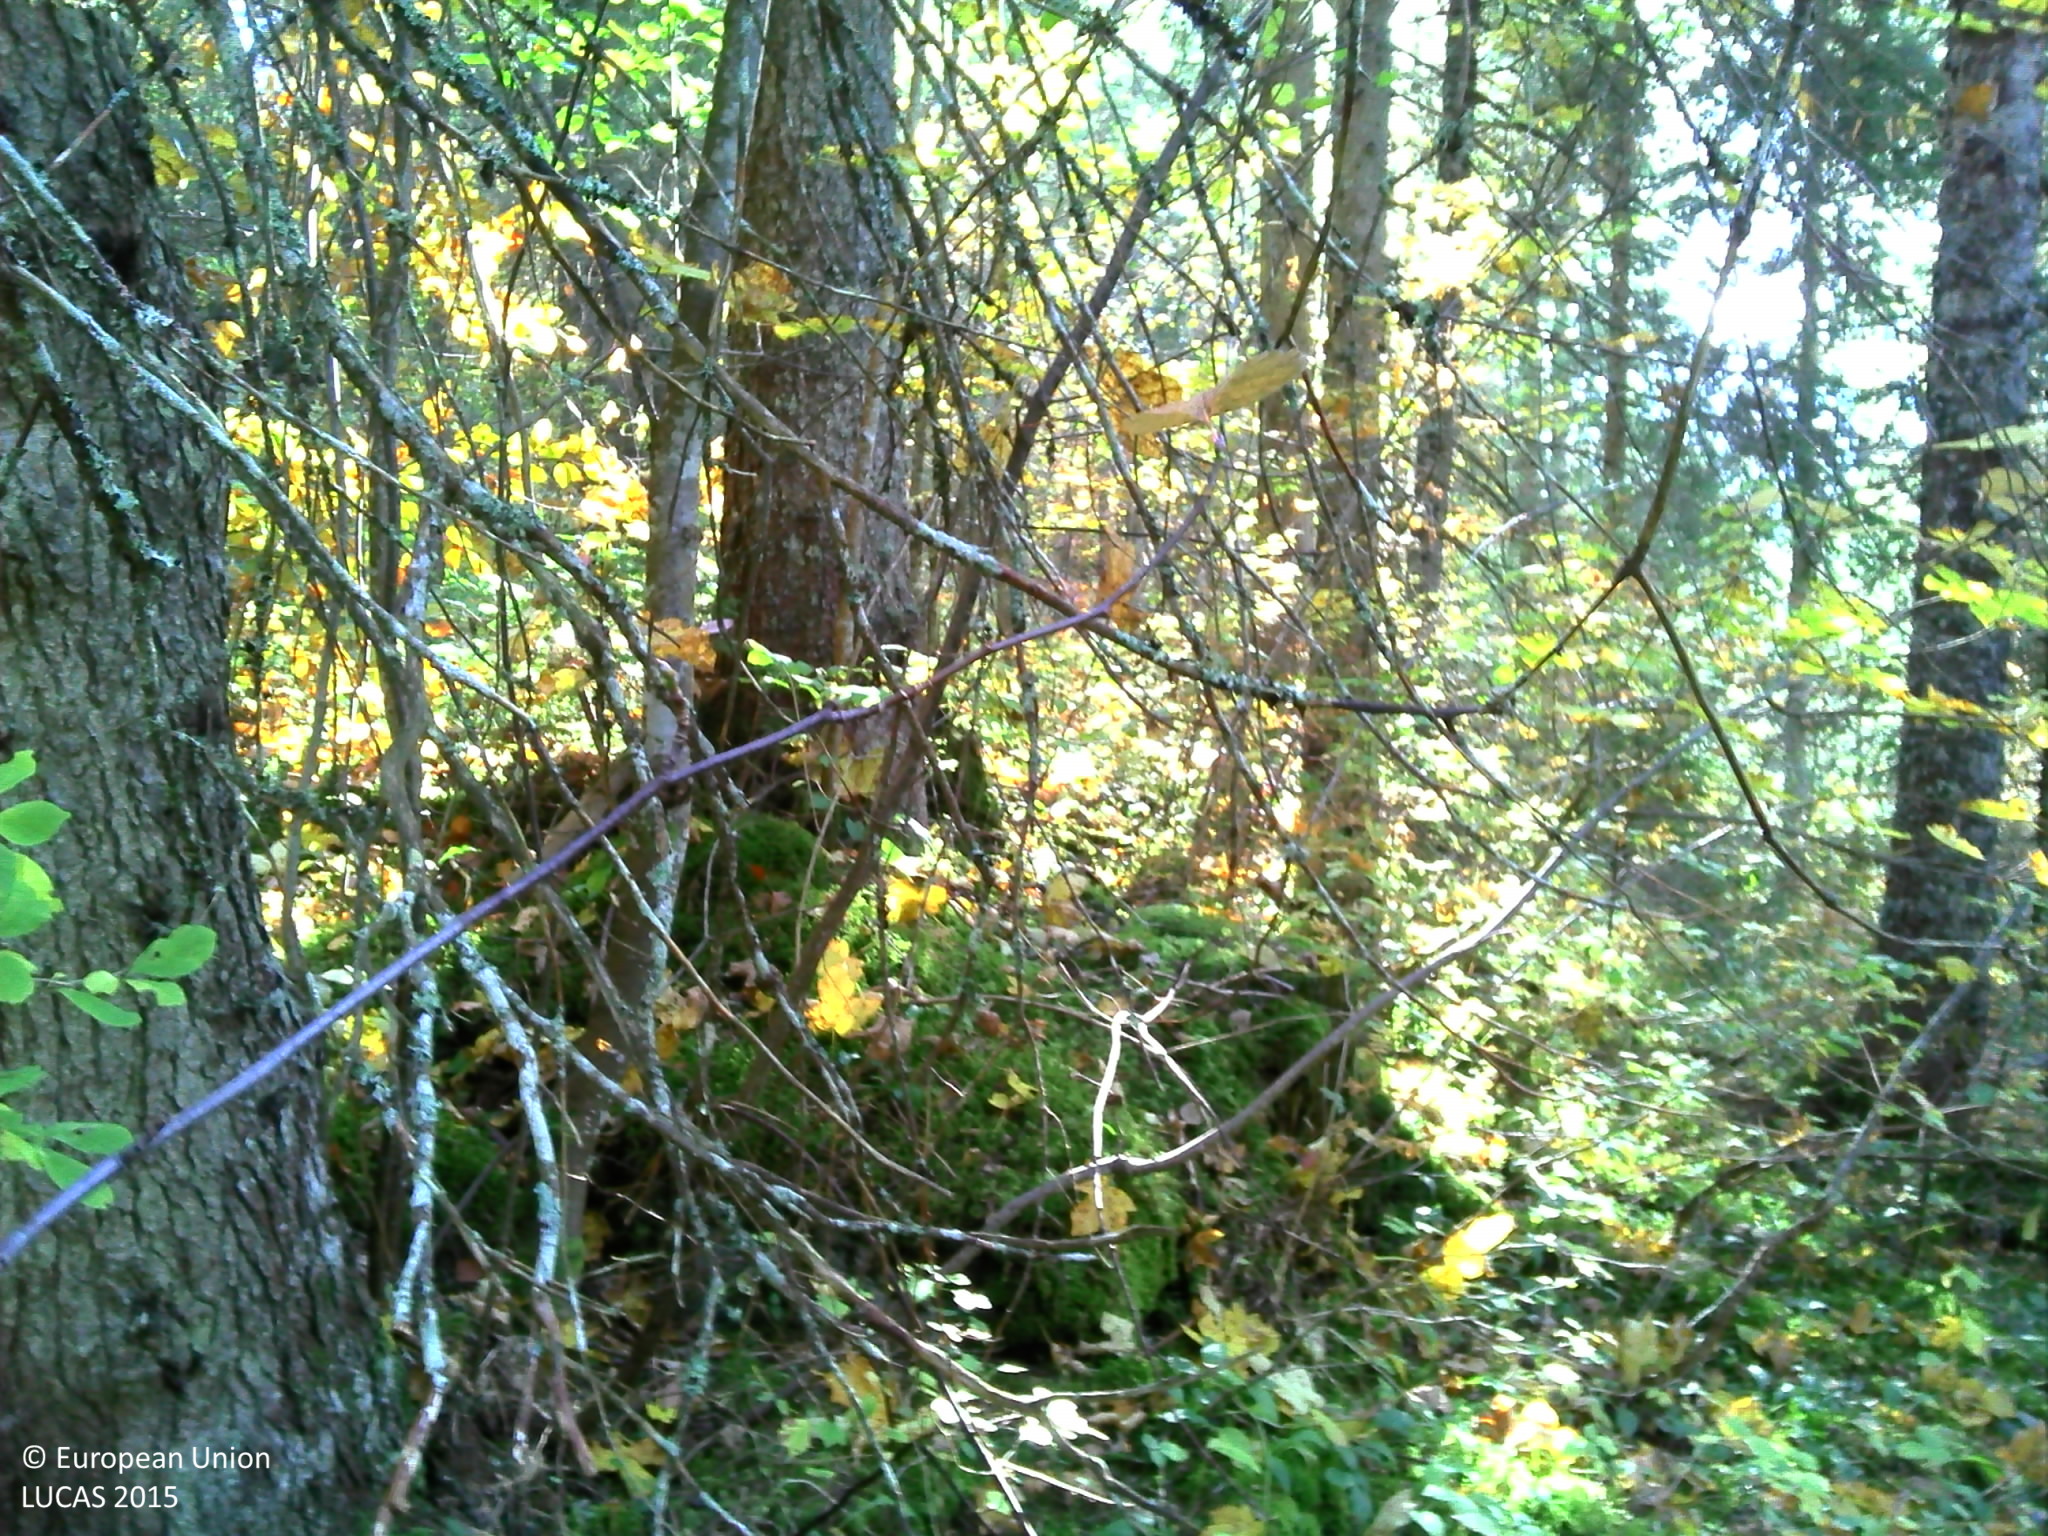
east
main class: Woodland
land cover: Spruce dominated coniferous woodland
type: hemiboreal forest and nemoral coniferous forest and mixed broadleaved-coniferous forest
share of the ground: > 75 %
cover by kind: coniferous forest trees 75 %, shrubs 10 %, herbaceous plants 10 %, broadleaved forest trees 5 %
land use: Forestry
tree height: > 5 m
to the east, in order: Spruce dominated coniferous woodland; Tracks; Spruce dominated coniferous woodland; Tracks; Spruce dominated coniferous woodland
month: October
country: FR
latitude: 46.6037
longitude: 6.0732
